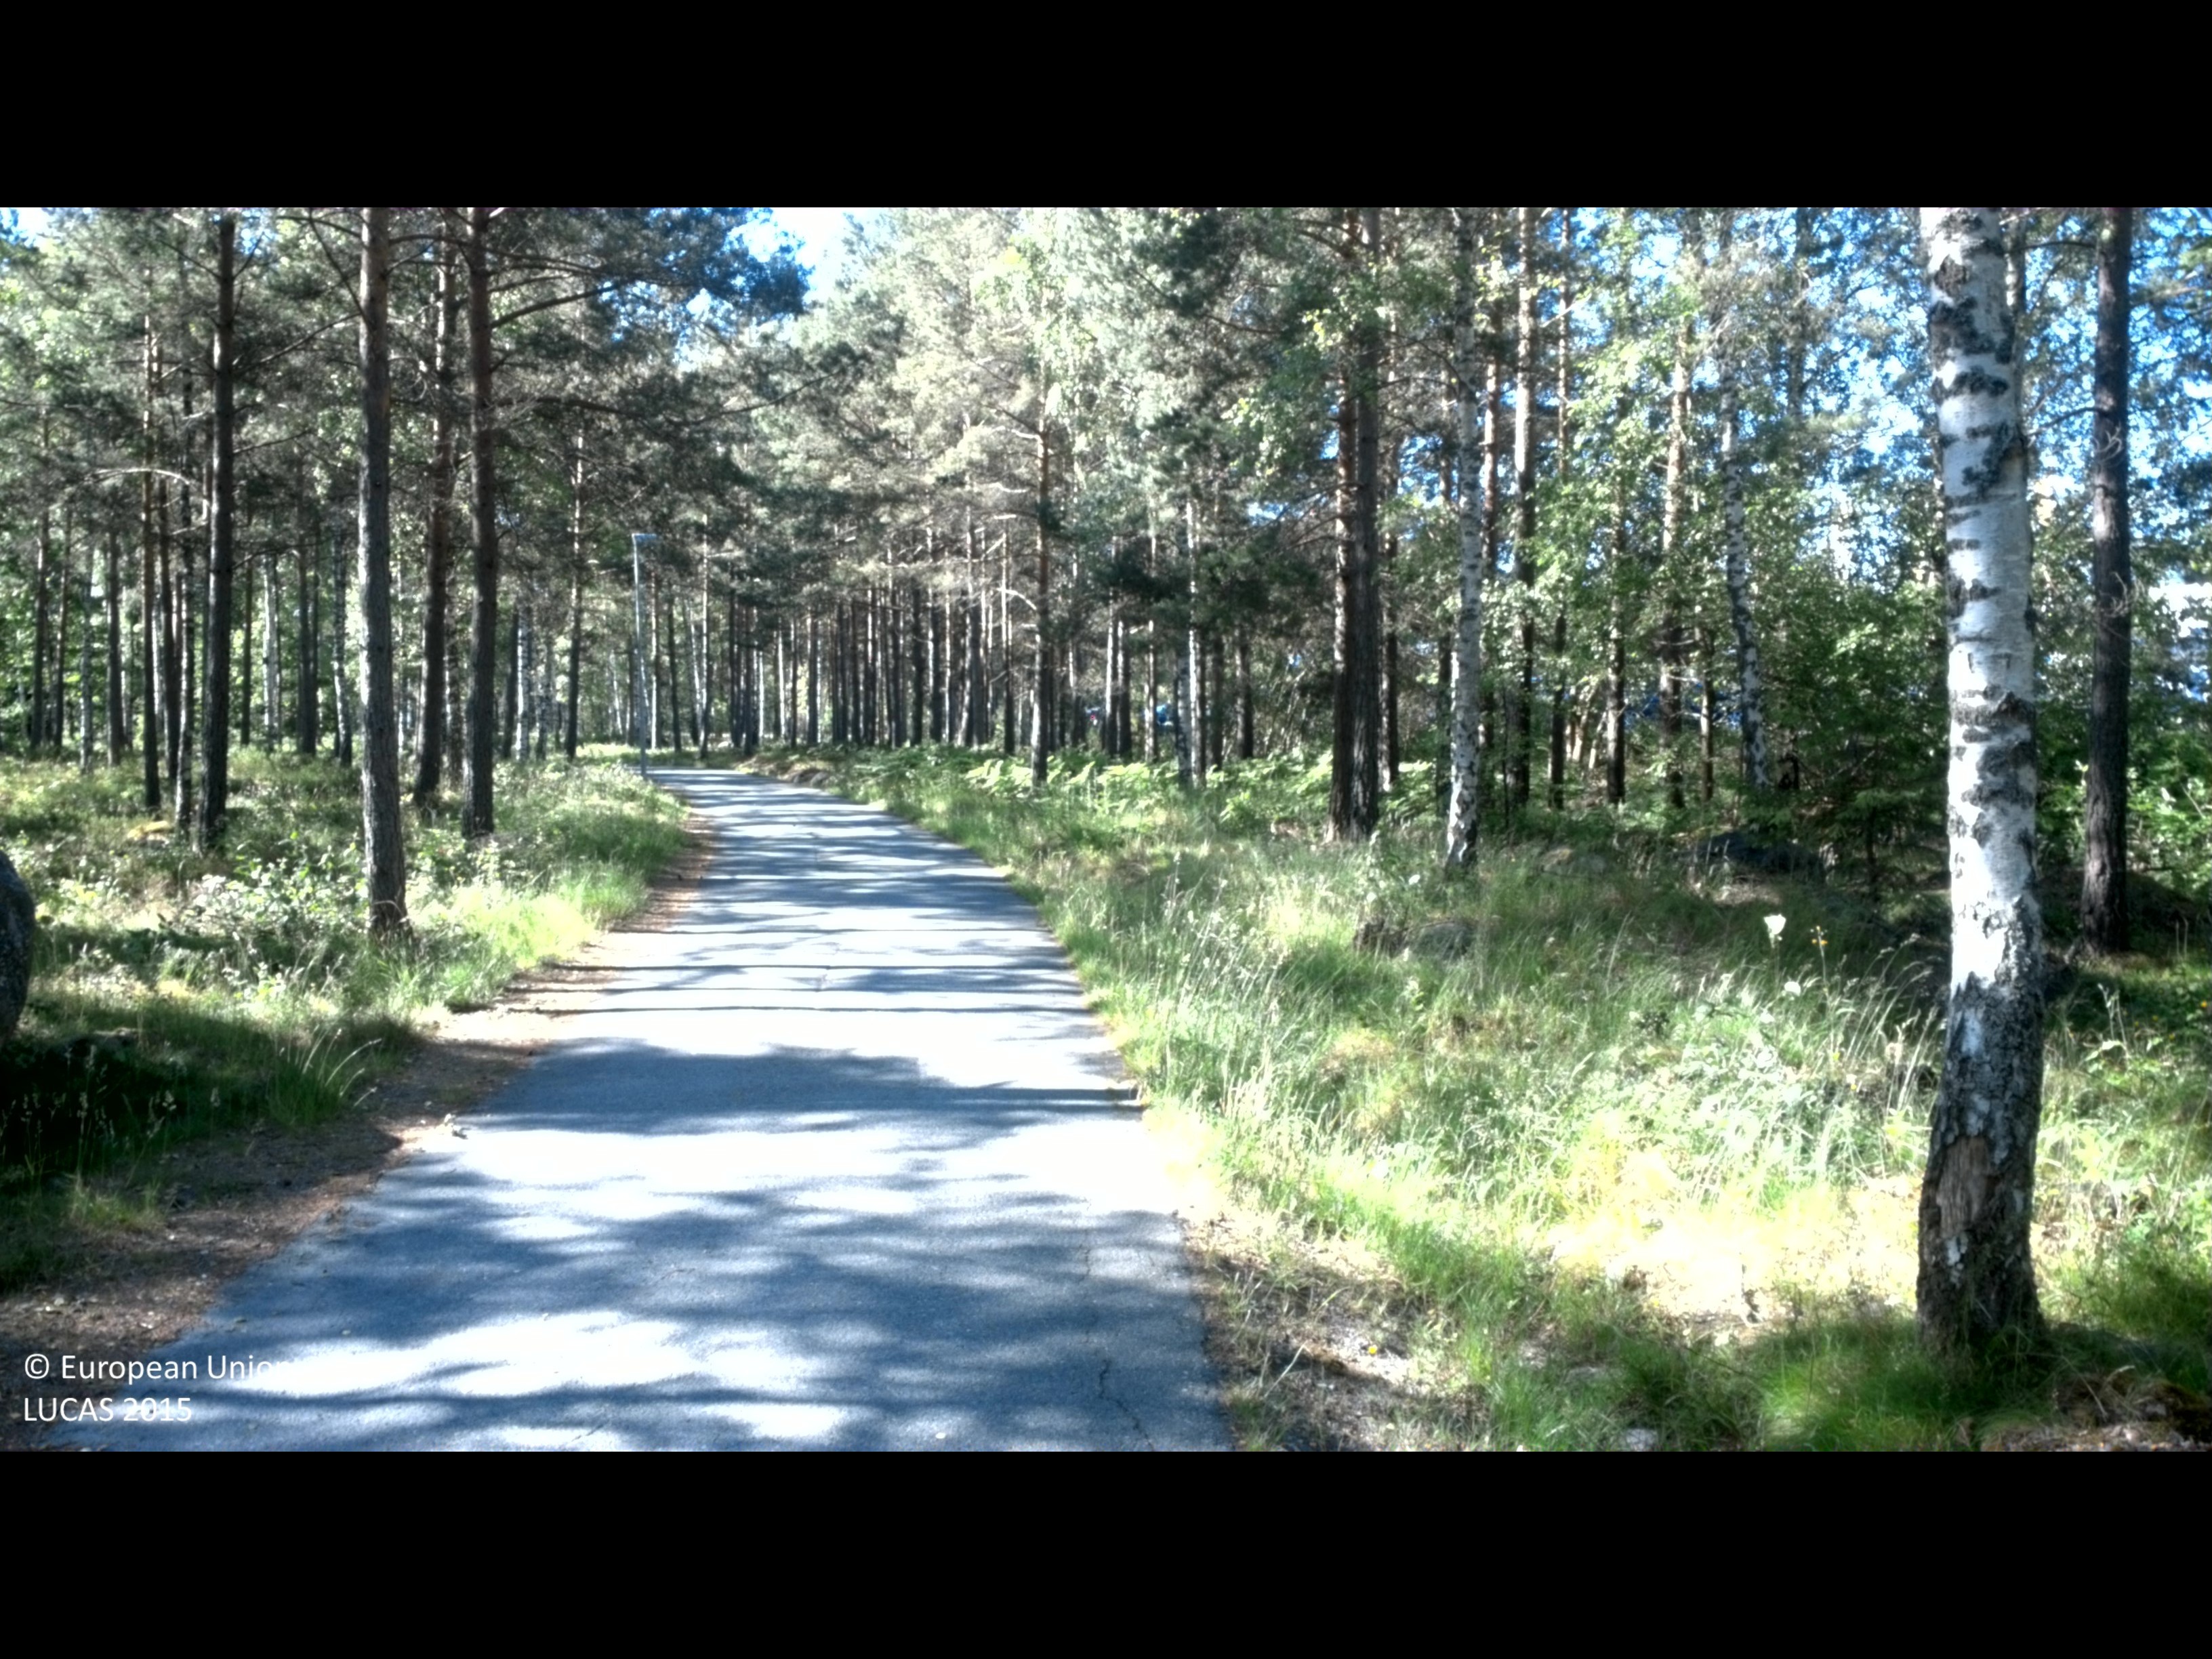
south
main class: Woodland
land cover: Broadleaved woodland
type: hemiboreal forest and nemoral coniferous forest and mixed broadleaved-coniferous forest
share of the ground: > 75 %
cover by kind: broadleaved forest trees 65 %, coniferous forest trees 20 %, herbaceous plants 15 %
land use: Amenities, museums, leisure
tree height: > 5 m
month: June
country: SE
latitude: 57.7683
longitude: 16.6054
